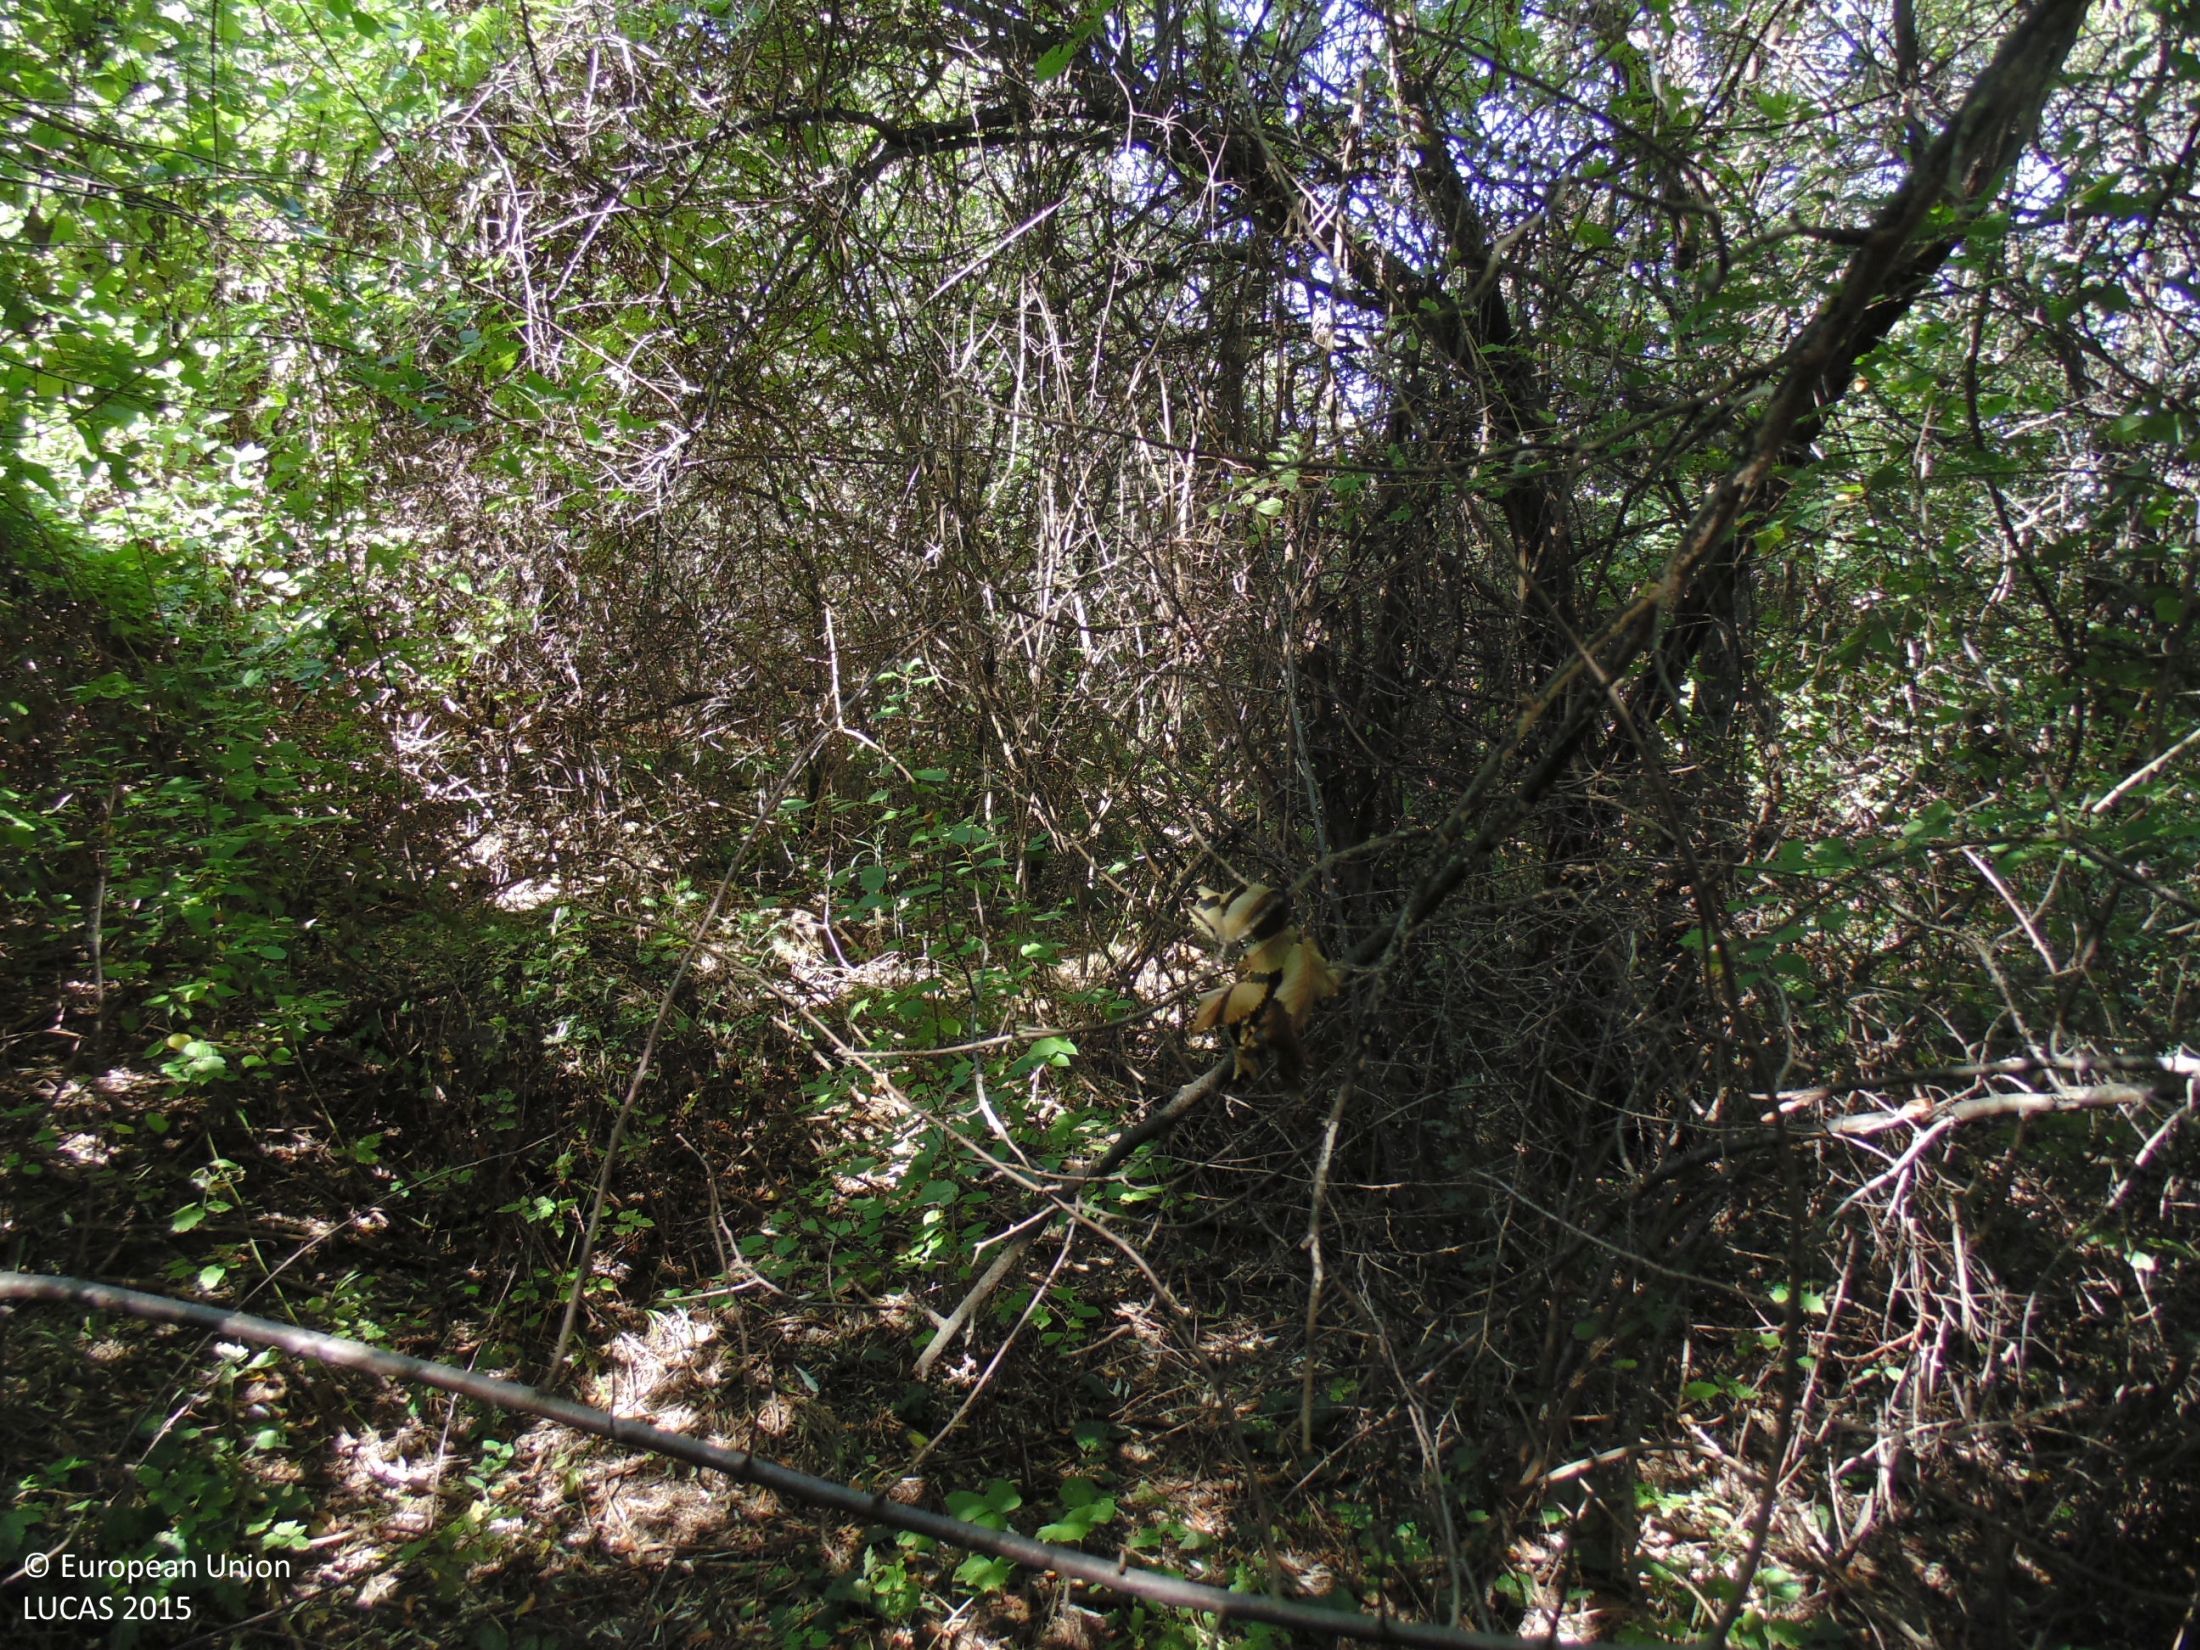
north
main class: Woodland
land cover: Broadleaved woodland
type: mesophytic deciduous forest
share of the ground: > 75 %
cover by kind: broadleaved forest trees 90 %, shrubs 5 %, unconsolidated bare surface 5 %
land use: Forestry
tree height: > 5 m
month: September
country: BG
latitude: 44.1162
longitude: 26.9802
